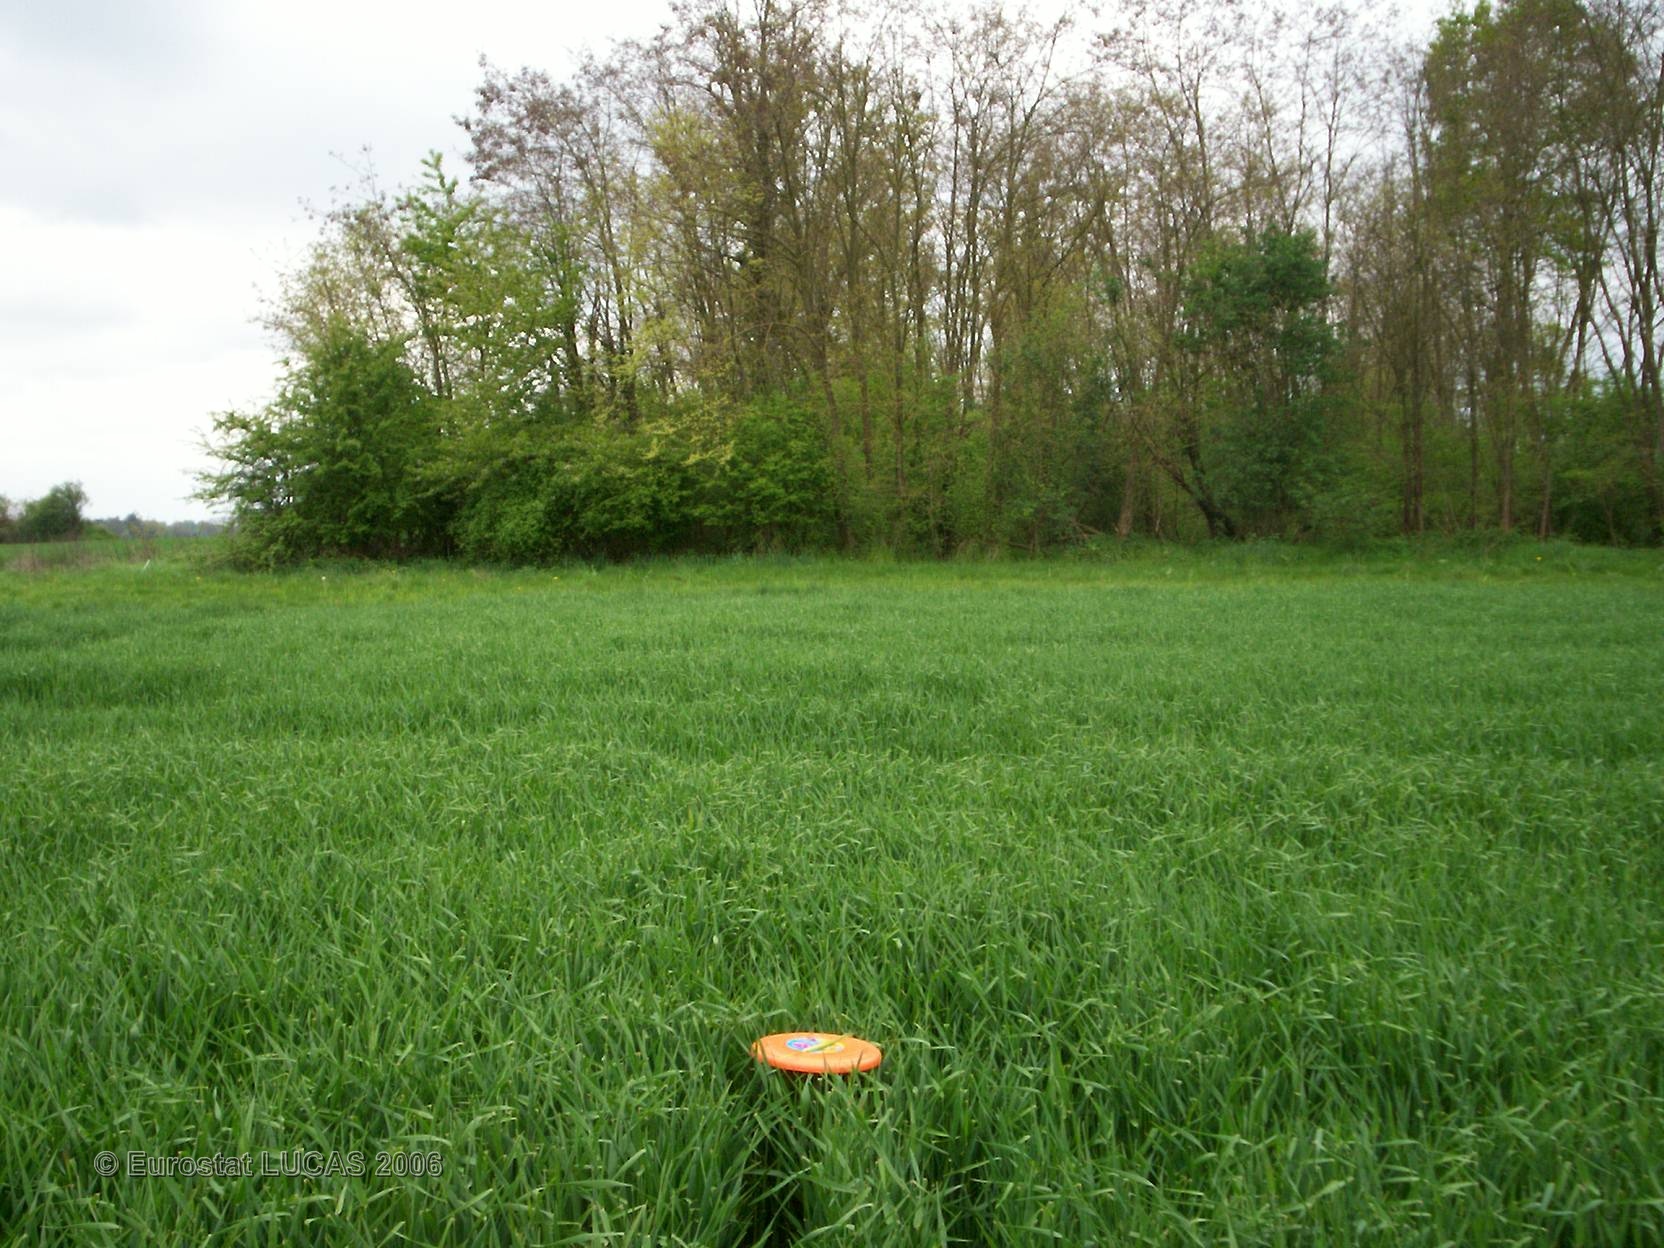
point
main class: Cropland
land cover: Barley
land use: Agriculture (excluding fallow land and kitchen gardens)
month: May
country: FR
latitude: 48.1755
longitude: 2.9049
